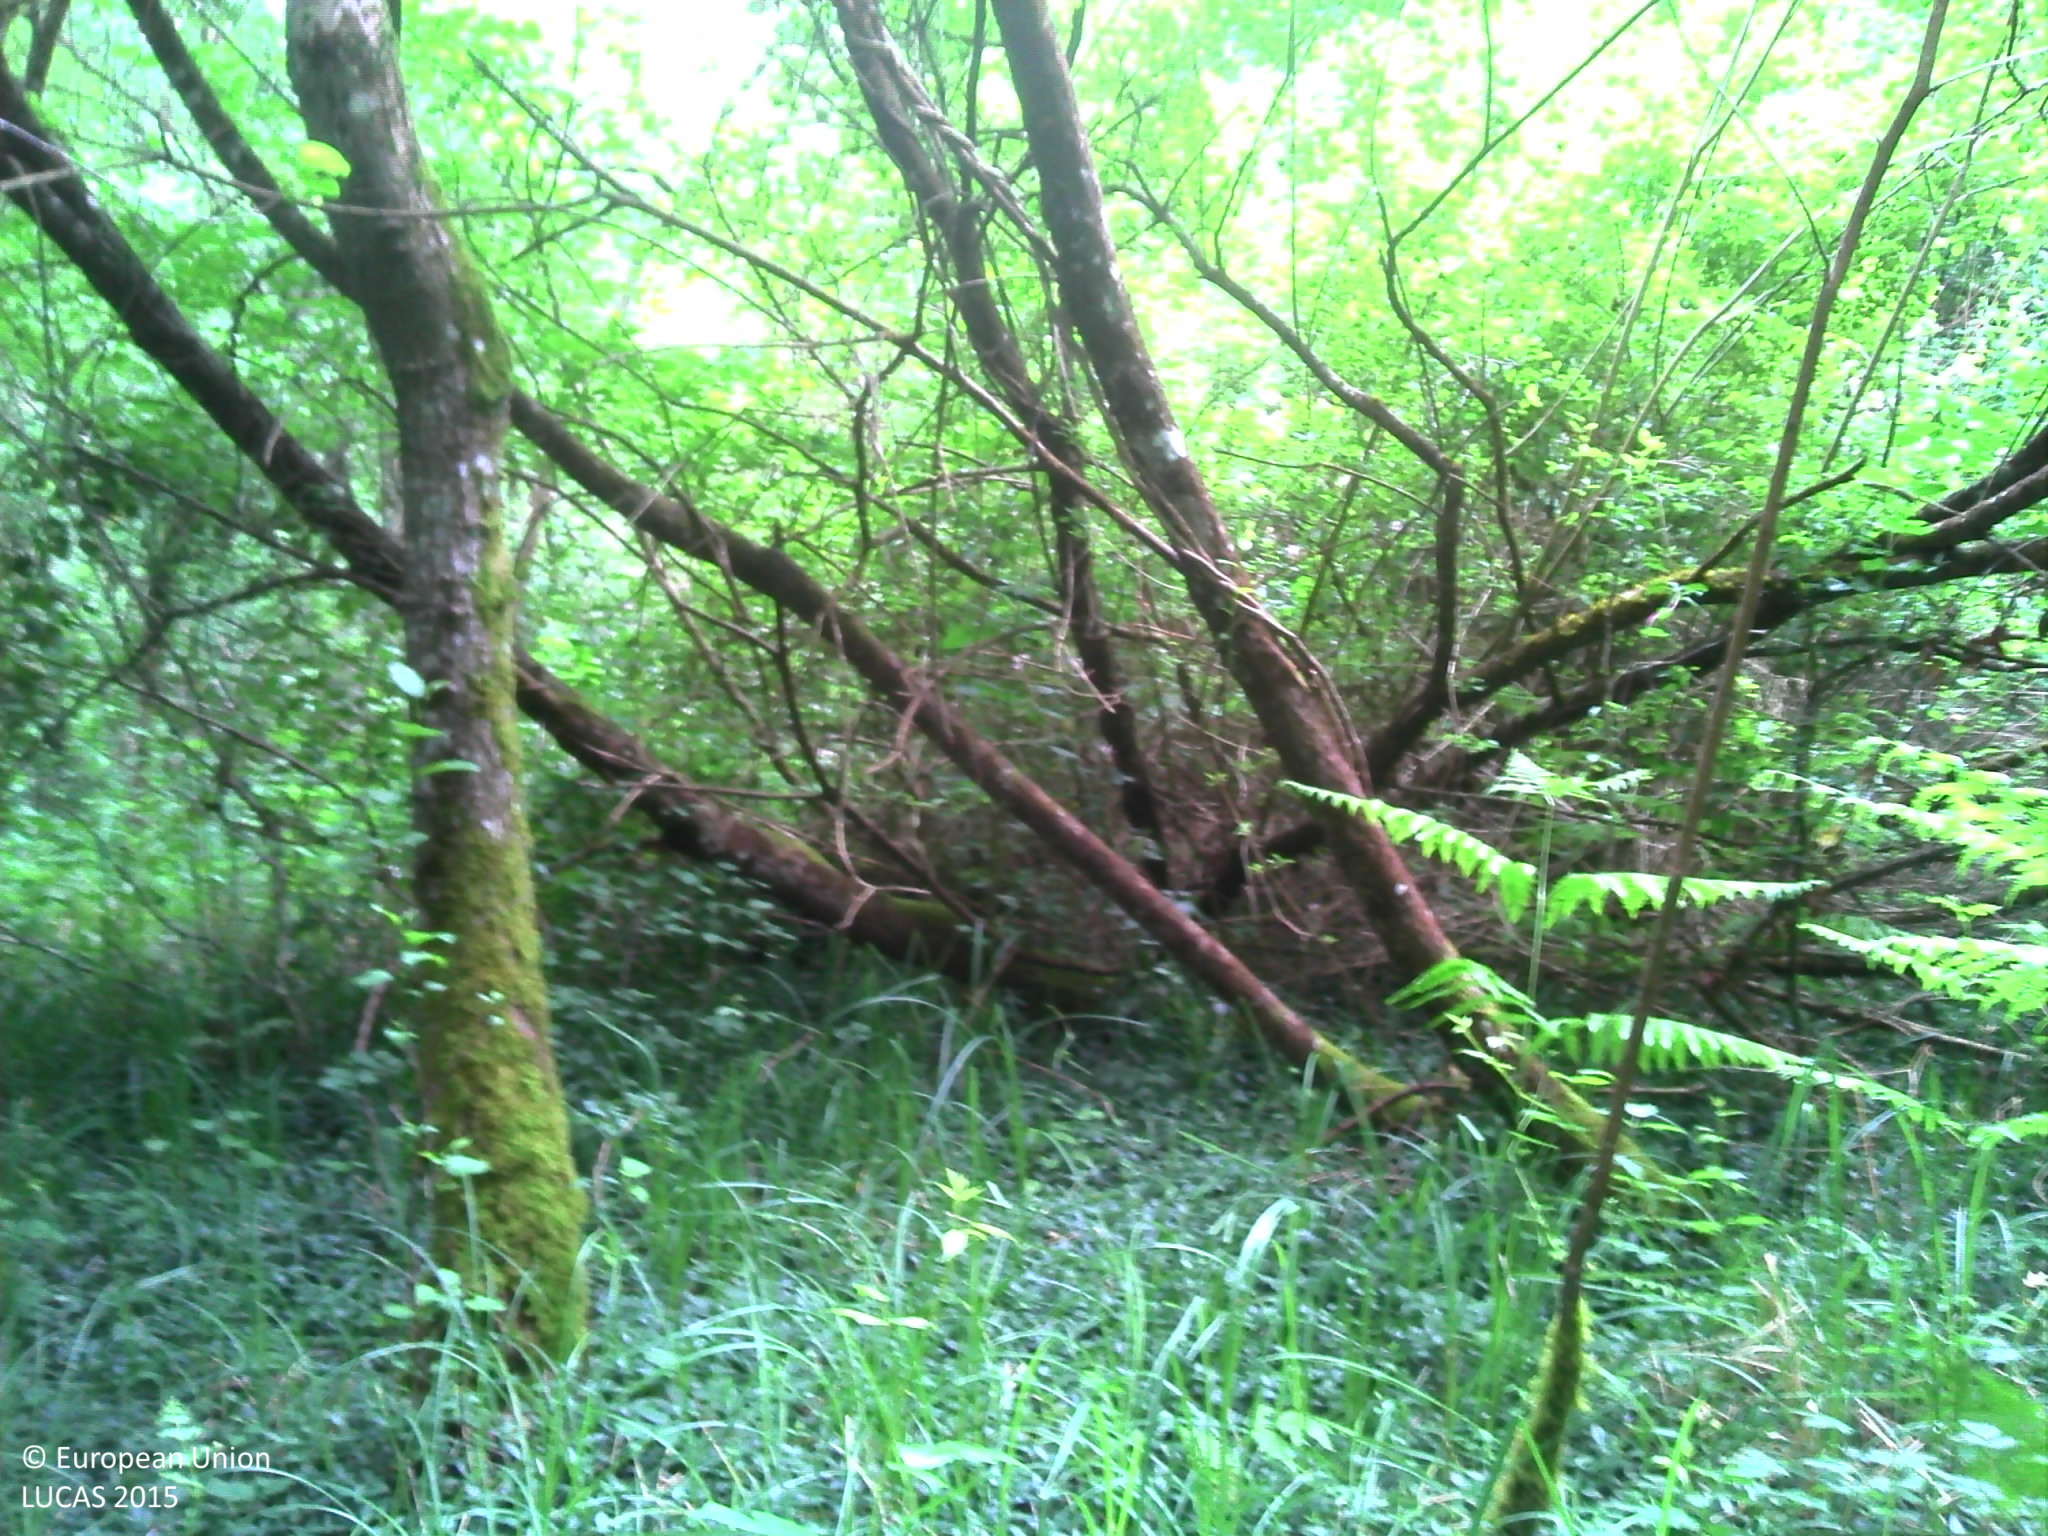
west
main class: Woodland
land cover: Broadleaved woodland
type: acidophilous oak and oak-birch forest
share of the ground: > 75 %
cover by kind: broadleaved forest trees 60 %, herbaceous plants 20 %, coniferous forest trees 10 %, lichens and mosses 10 %
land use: Forestry
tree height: > 5 m
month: June
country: FR
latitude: 47.4808
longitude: 0.0349
